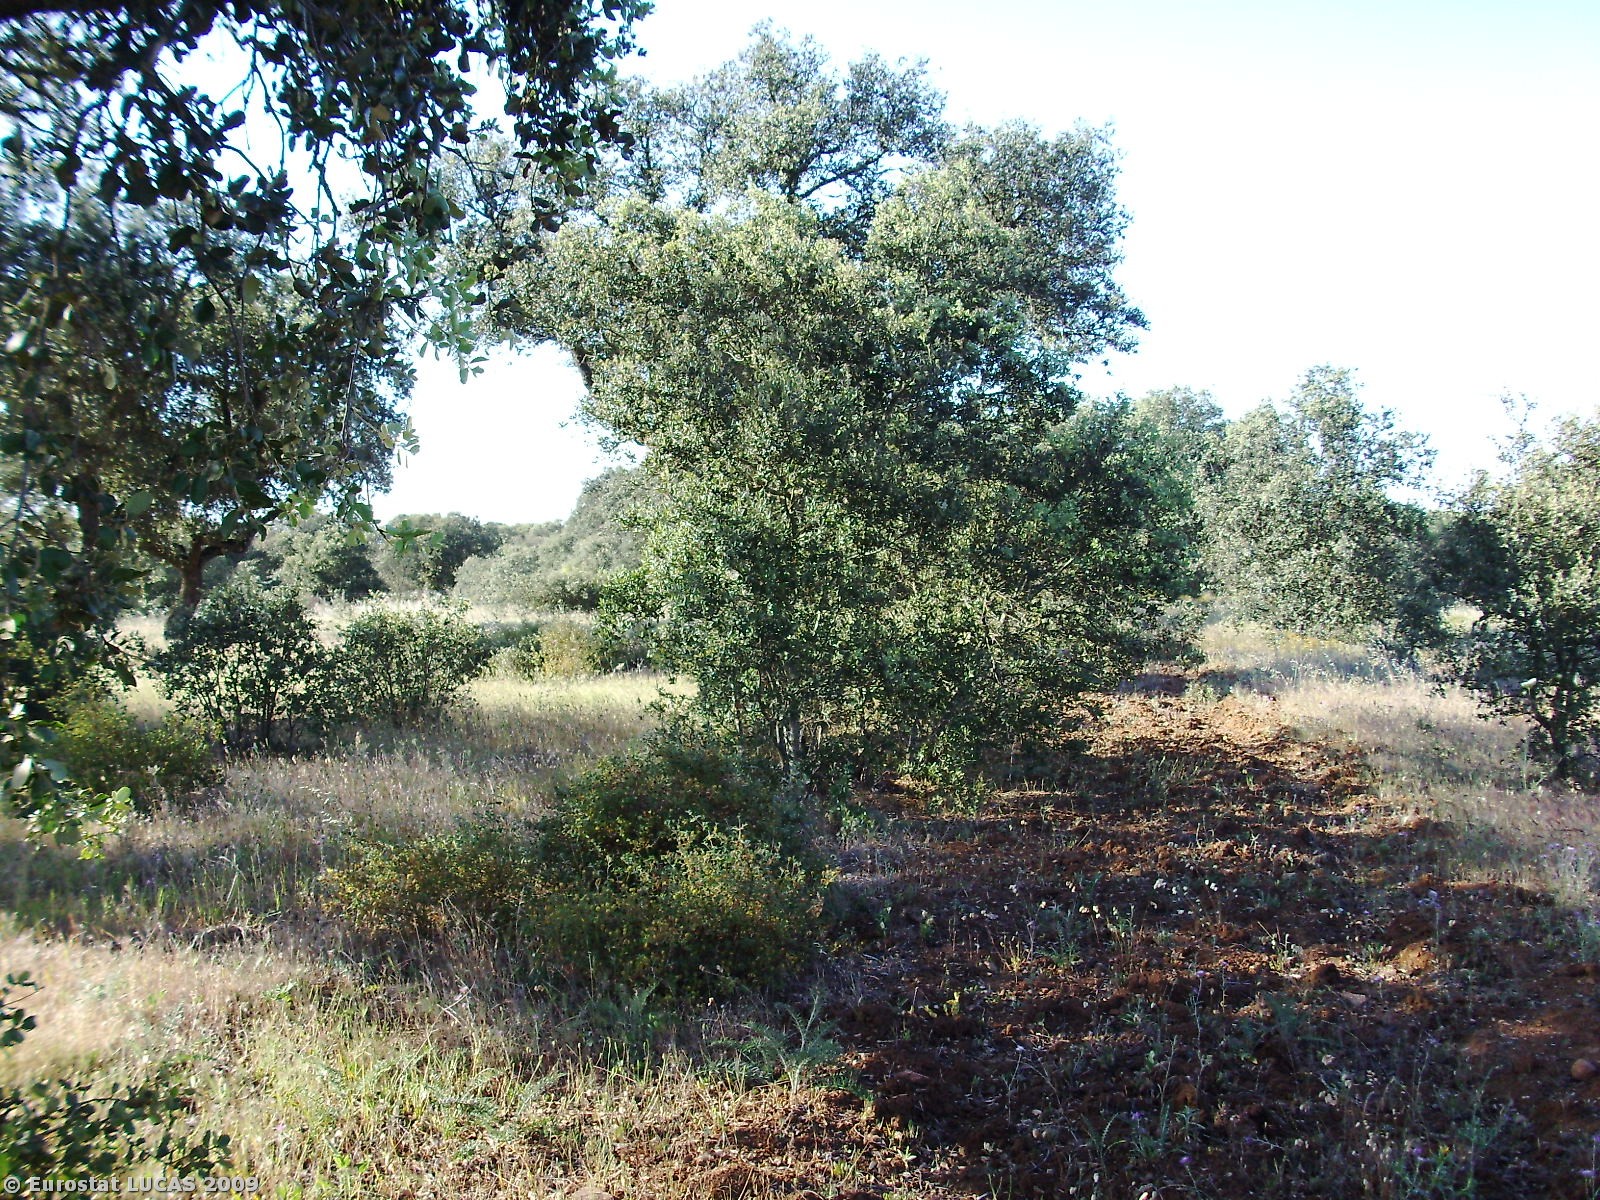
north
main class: Woodland
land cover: Broadleaved woodland
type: broadleaved evergreen forest
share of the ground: 25 - 50 %
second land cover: Spontaneously vegetated surfaces
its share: 50 - 75 %
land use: Forestry
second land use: Fallow land
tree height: > 5 m
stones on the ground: 10 - 25 %
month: May
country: PT
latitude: 38.9870
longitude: -7.3391
